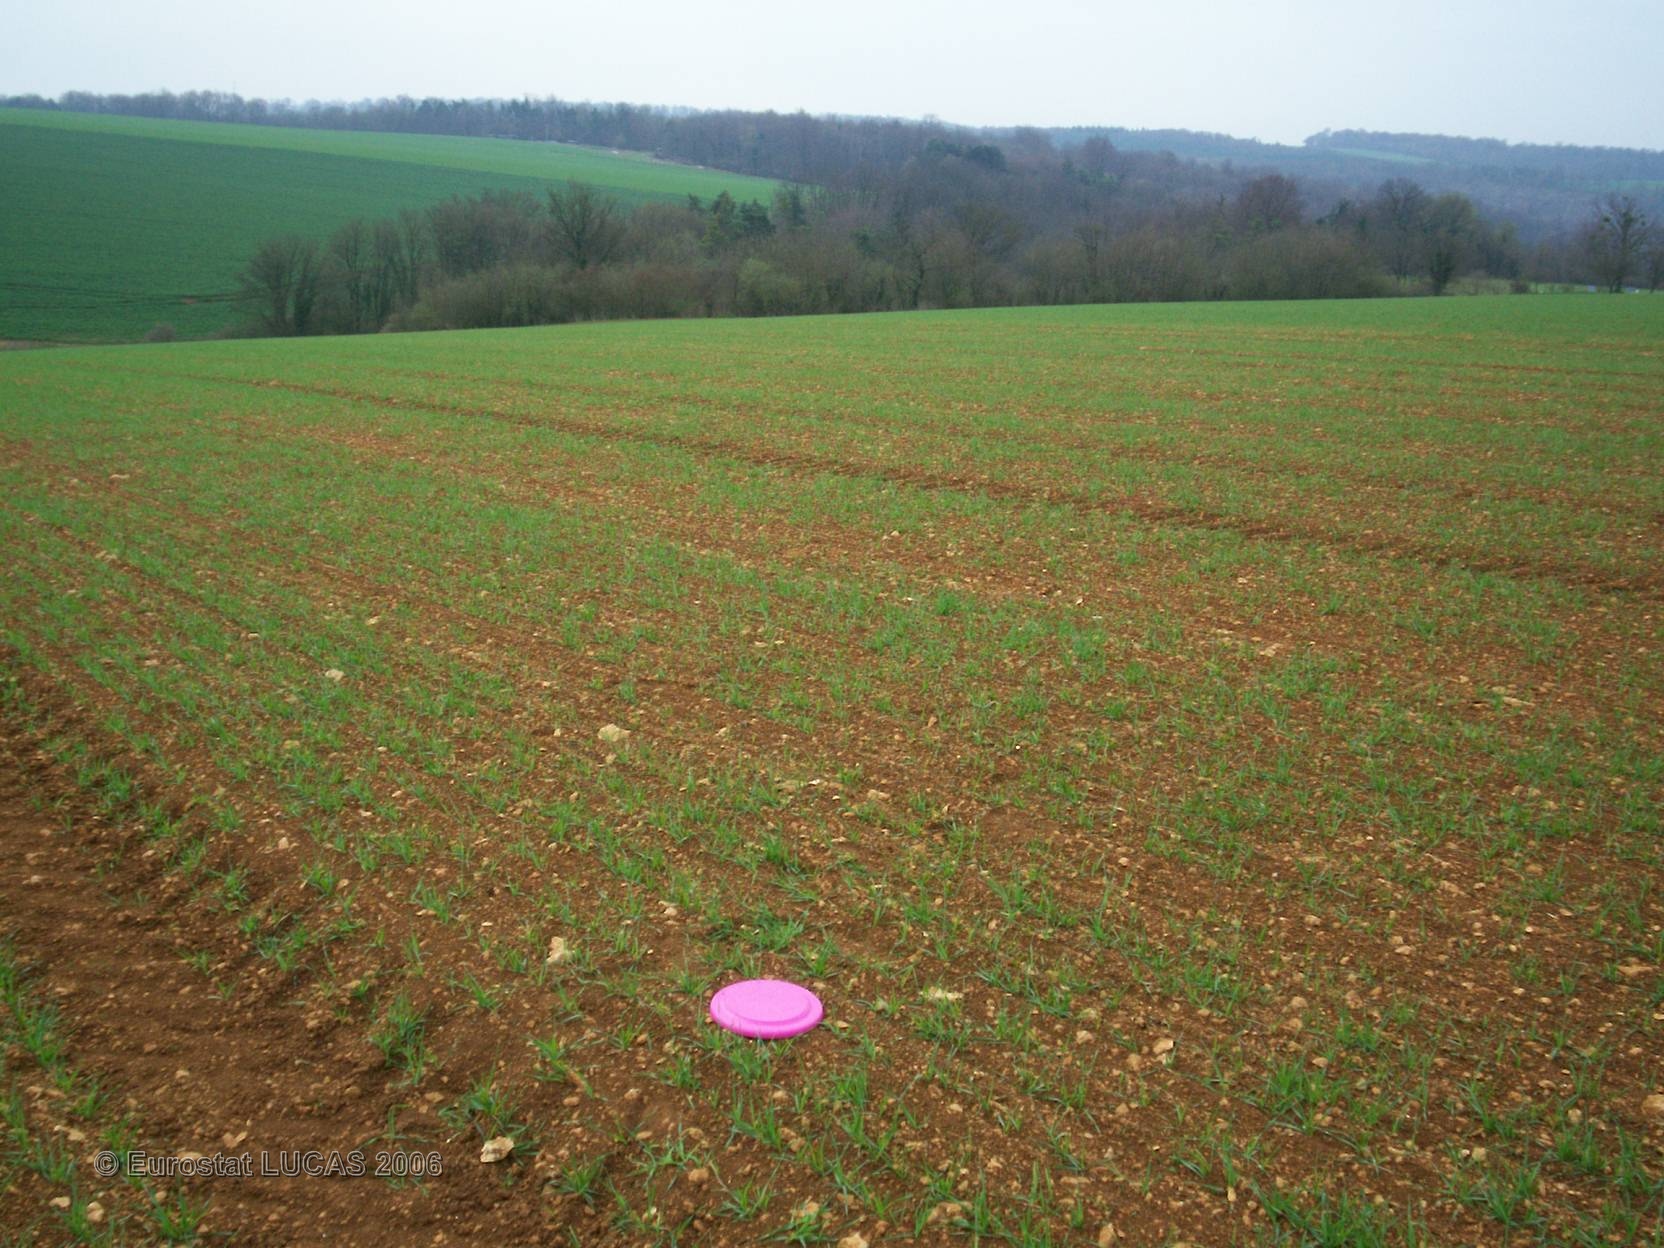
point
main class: Cropland
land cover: Barley
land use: Agriculture (excluding fallow land and kitchen gardens)
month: April
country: FR
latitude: 48.8518
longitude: 5.9520
